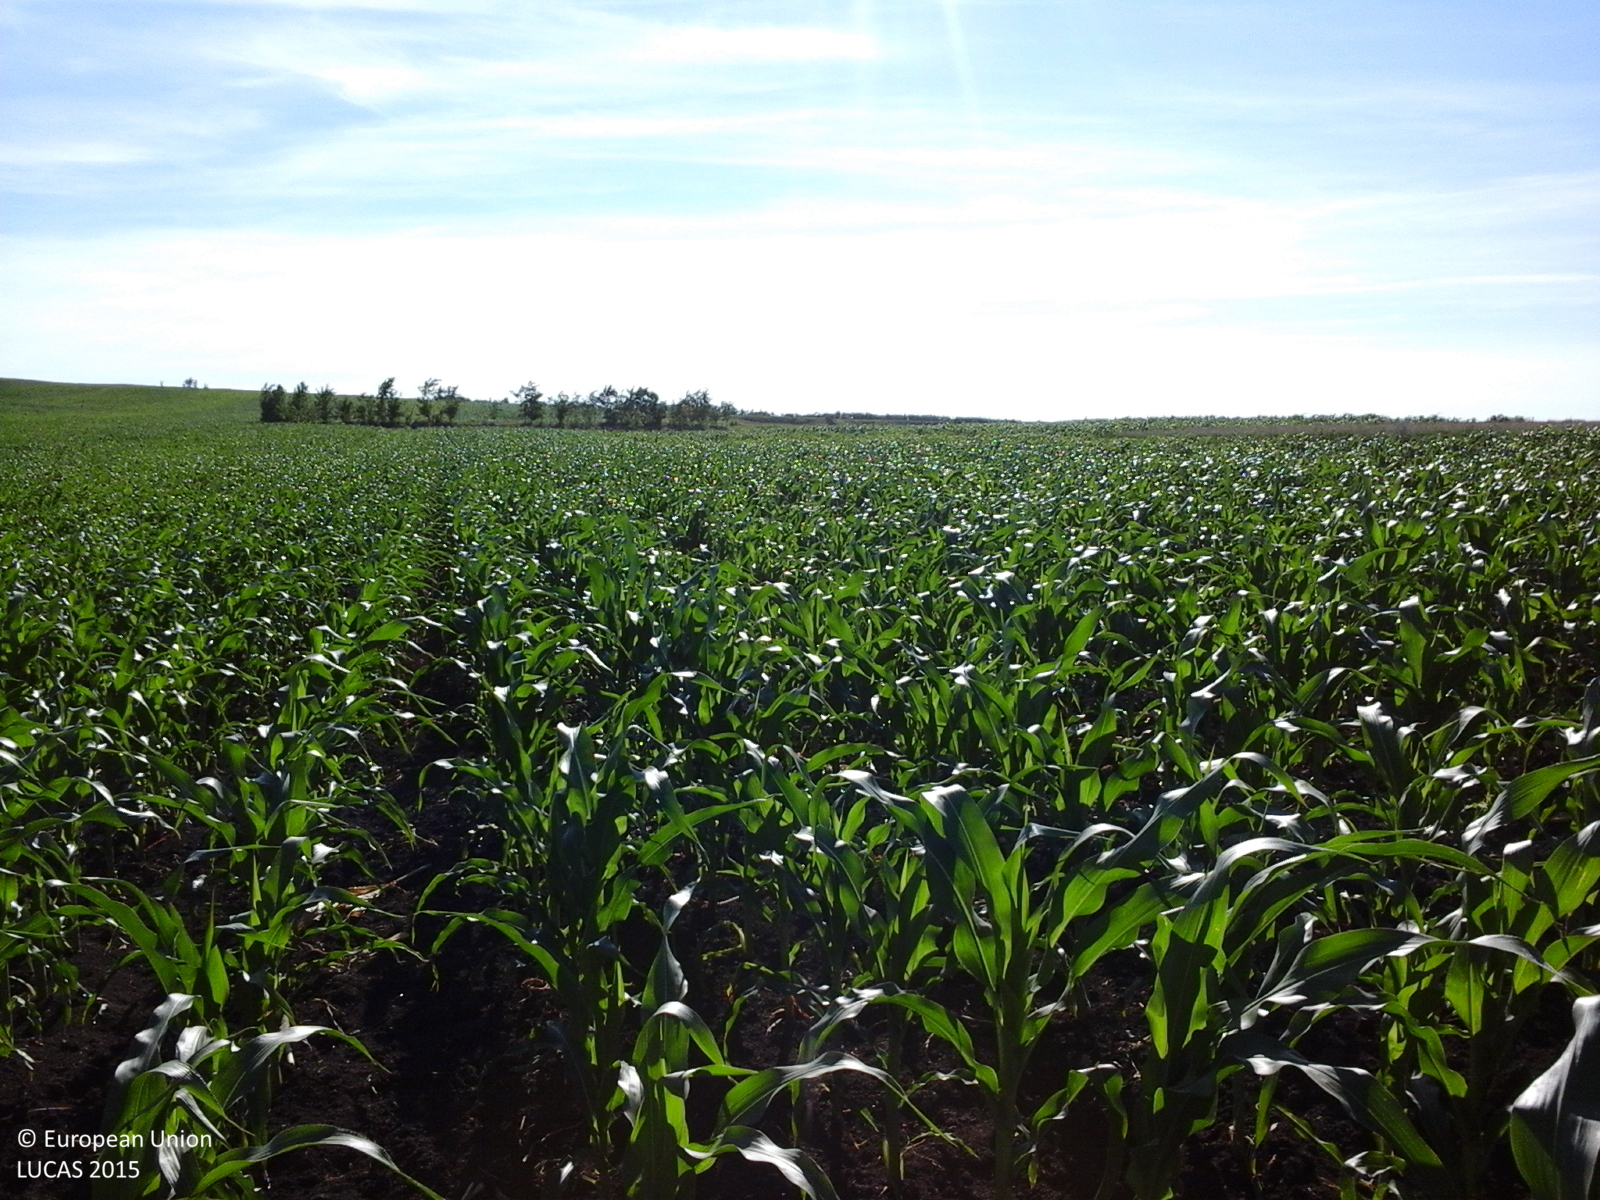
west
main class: Cropland
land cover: Maize
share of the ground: 50 - 75 %
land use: Agriculture (excluding fallow land and kitchen gardens)
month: June
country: RO
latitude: 47.4760
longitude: 27.1312
